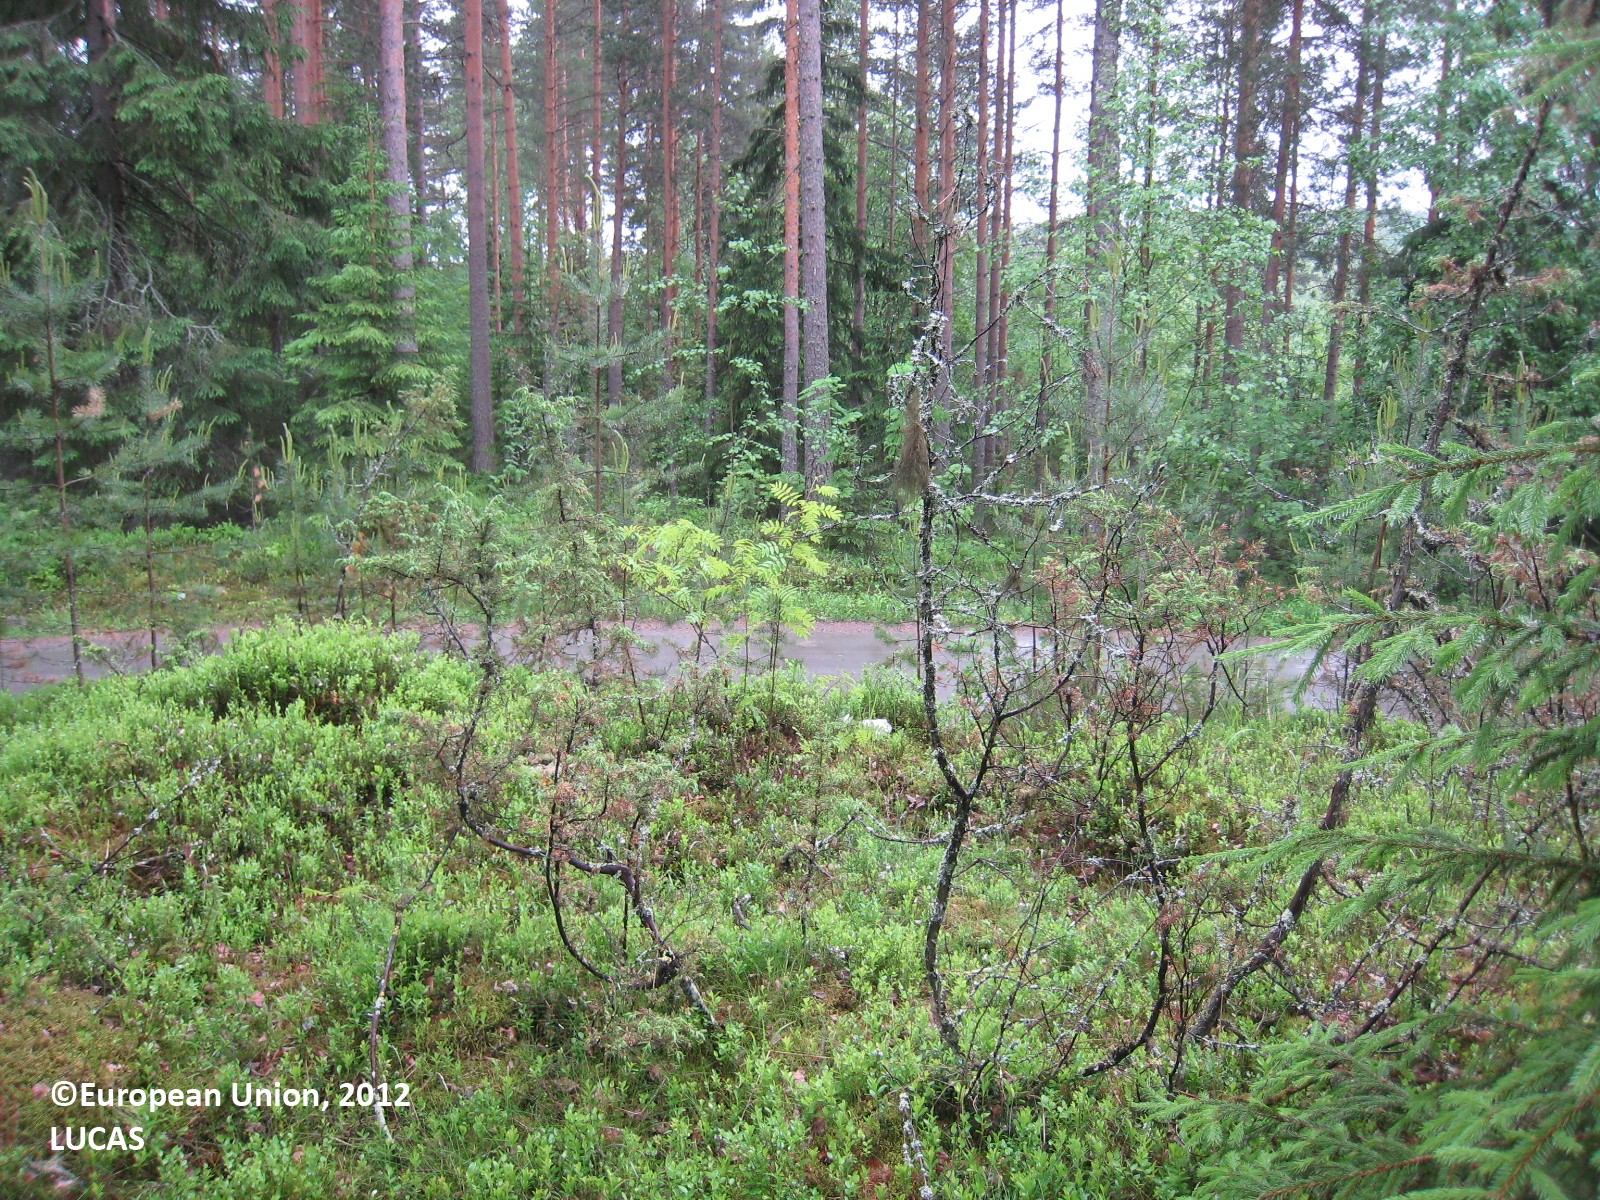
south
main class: Woodland
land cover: Pine dominated mixed woodland
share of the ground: 50 - 75 %
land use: Forestry
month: June
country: FI
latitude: 62.2972
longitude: 25.8763
